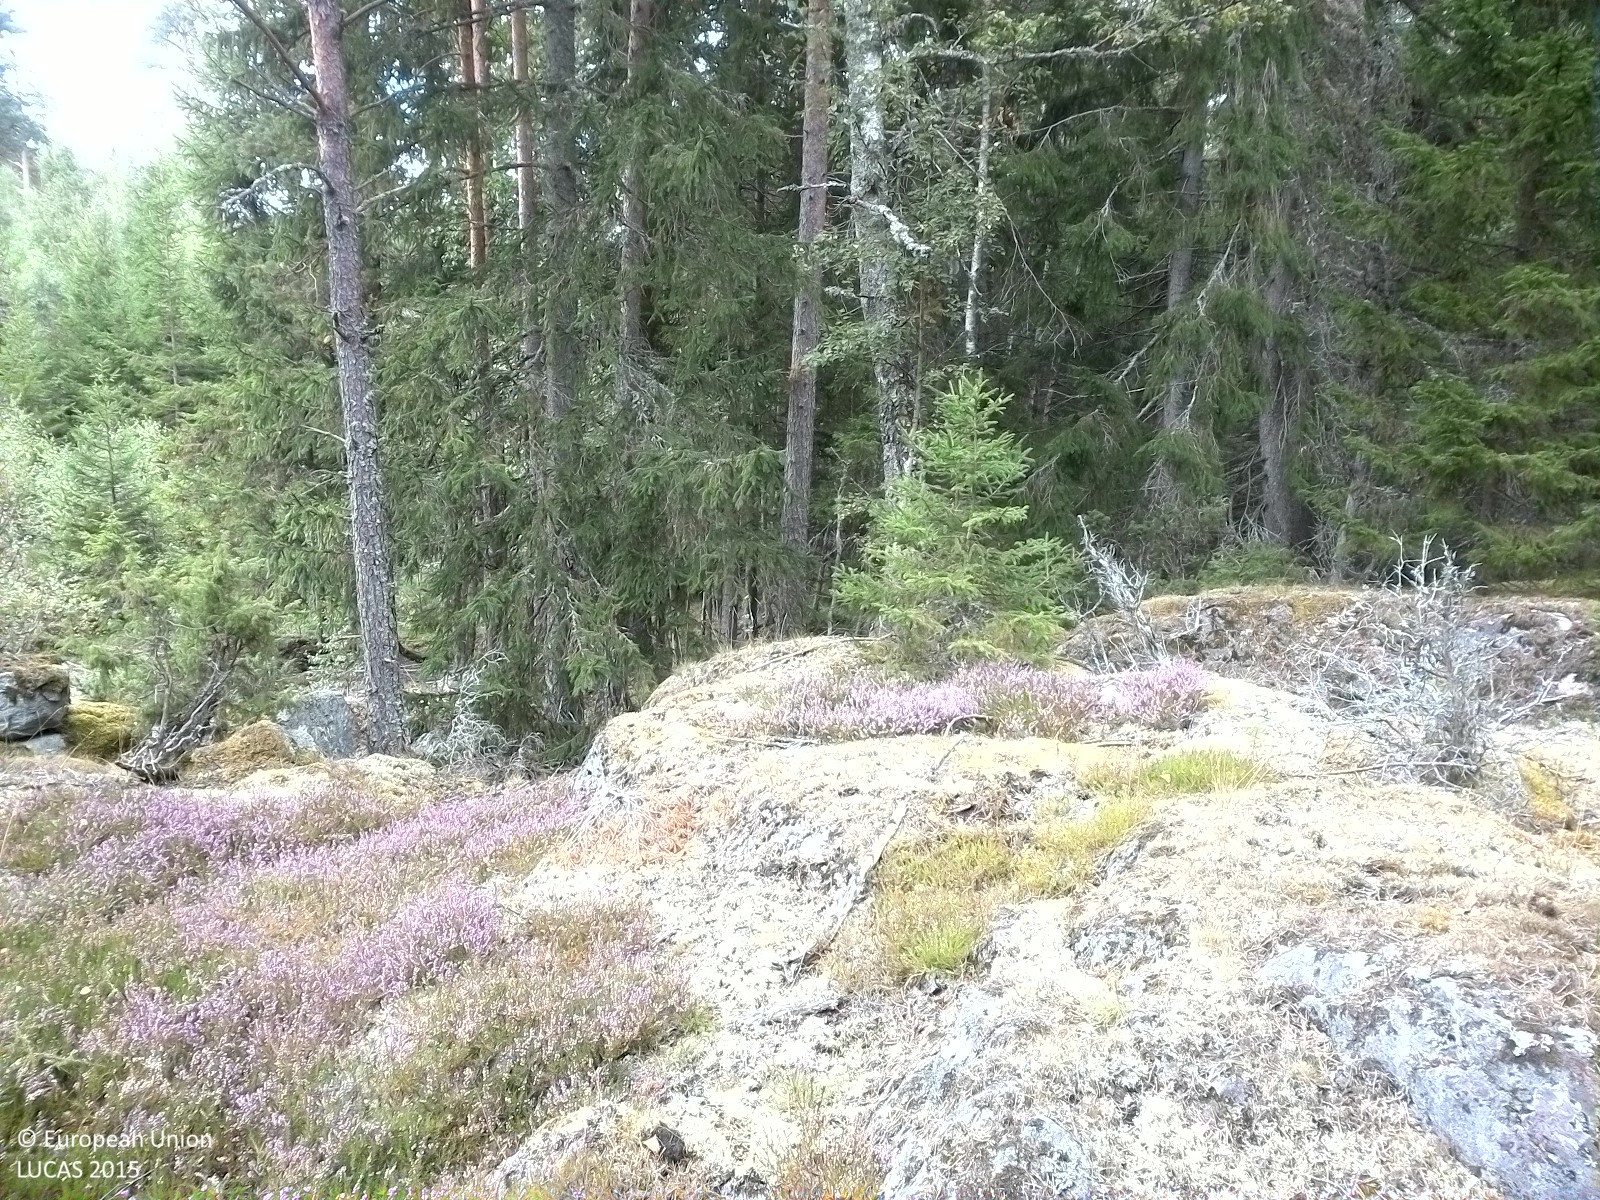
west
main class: Shrubland
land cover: Shrubland with sparse tree cover
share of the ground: 50 - 75 %
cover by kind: shrubs 55 %, lichens and mosses 20 %, coniferous forest trees 5 %
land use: Semi-natural and natural areas not in use
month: August
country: SE
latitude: 59.0070
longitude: 15.5468
